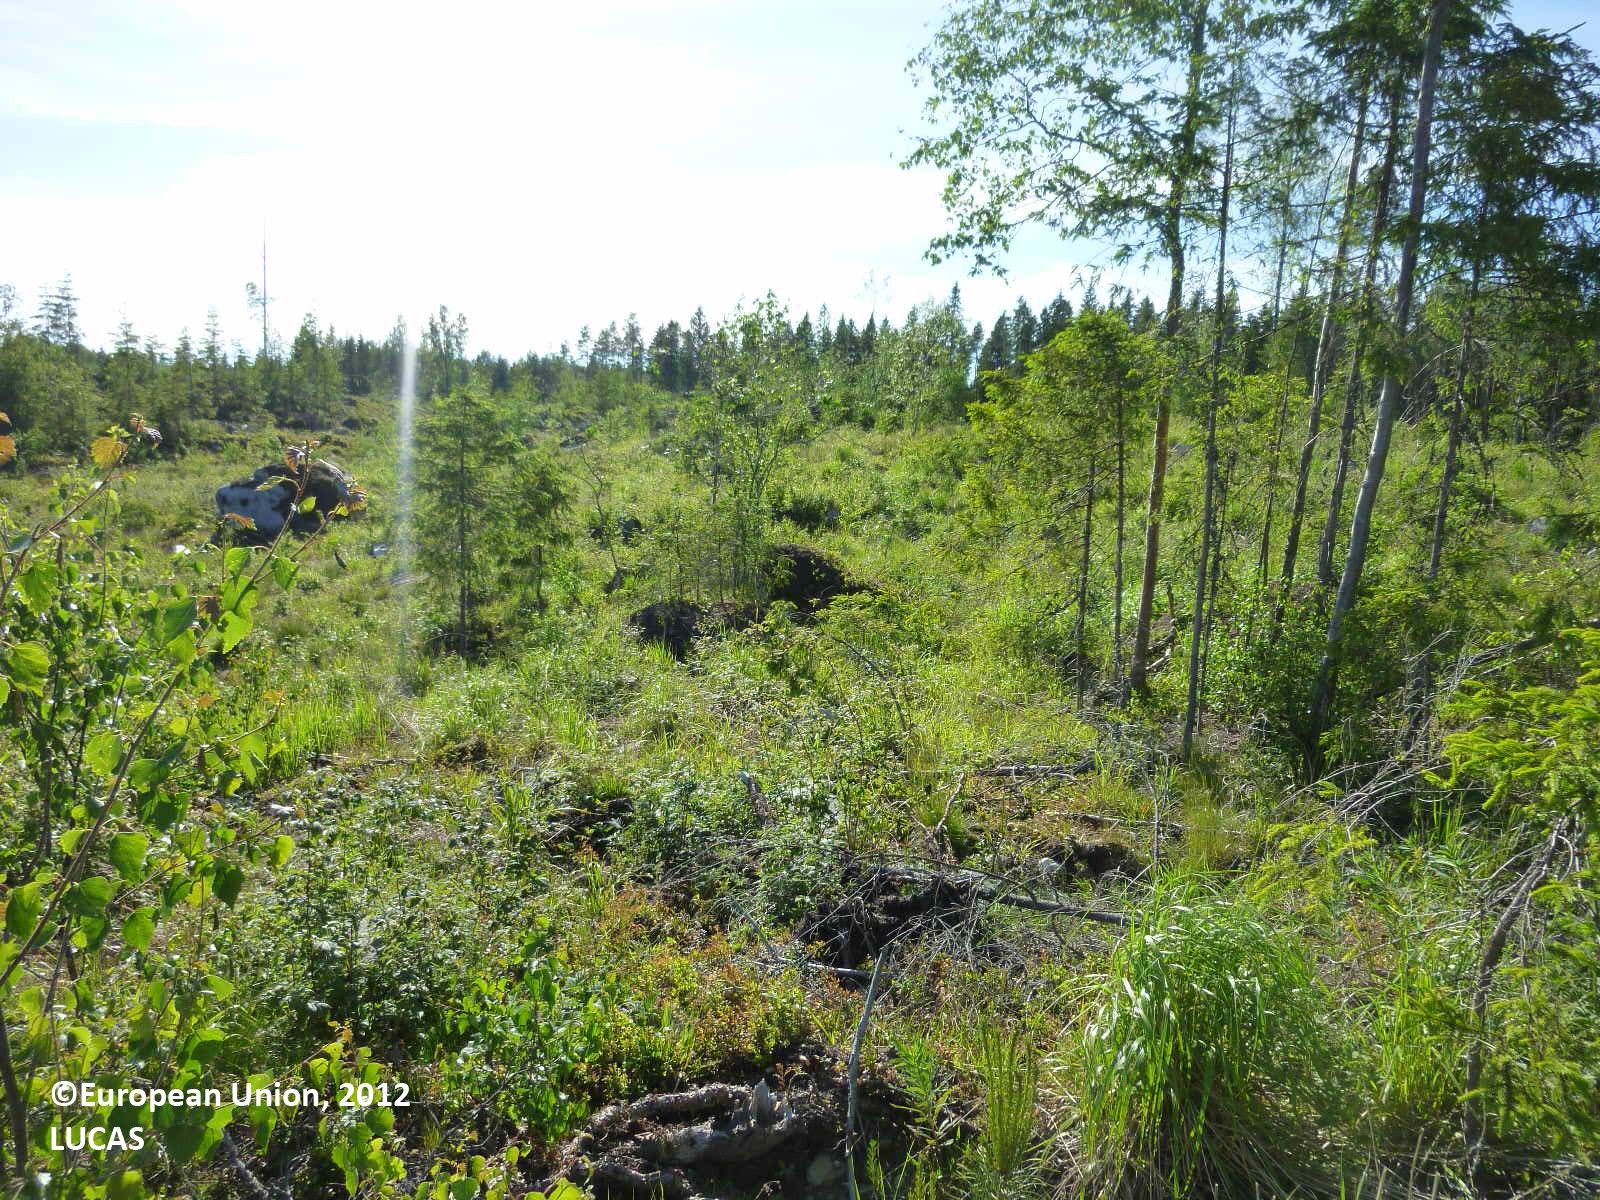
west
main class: Shrubland
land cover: Shrubland with sparse tree cover
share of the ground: 25 - 50 %
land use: Forestry
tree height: < 5 m
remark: Clear cut
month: June
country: FI
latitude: 61.5072
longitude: 22.0268
